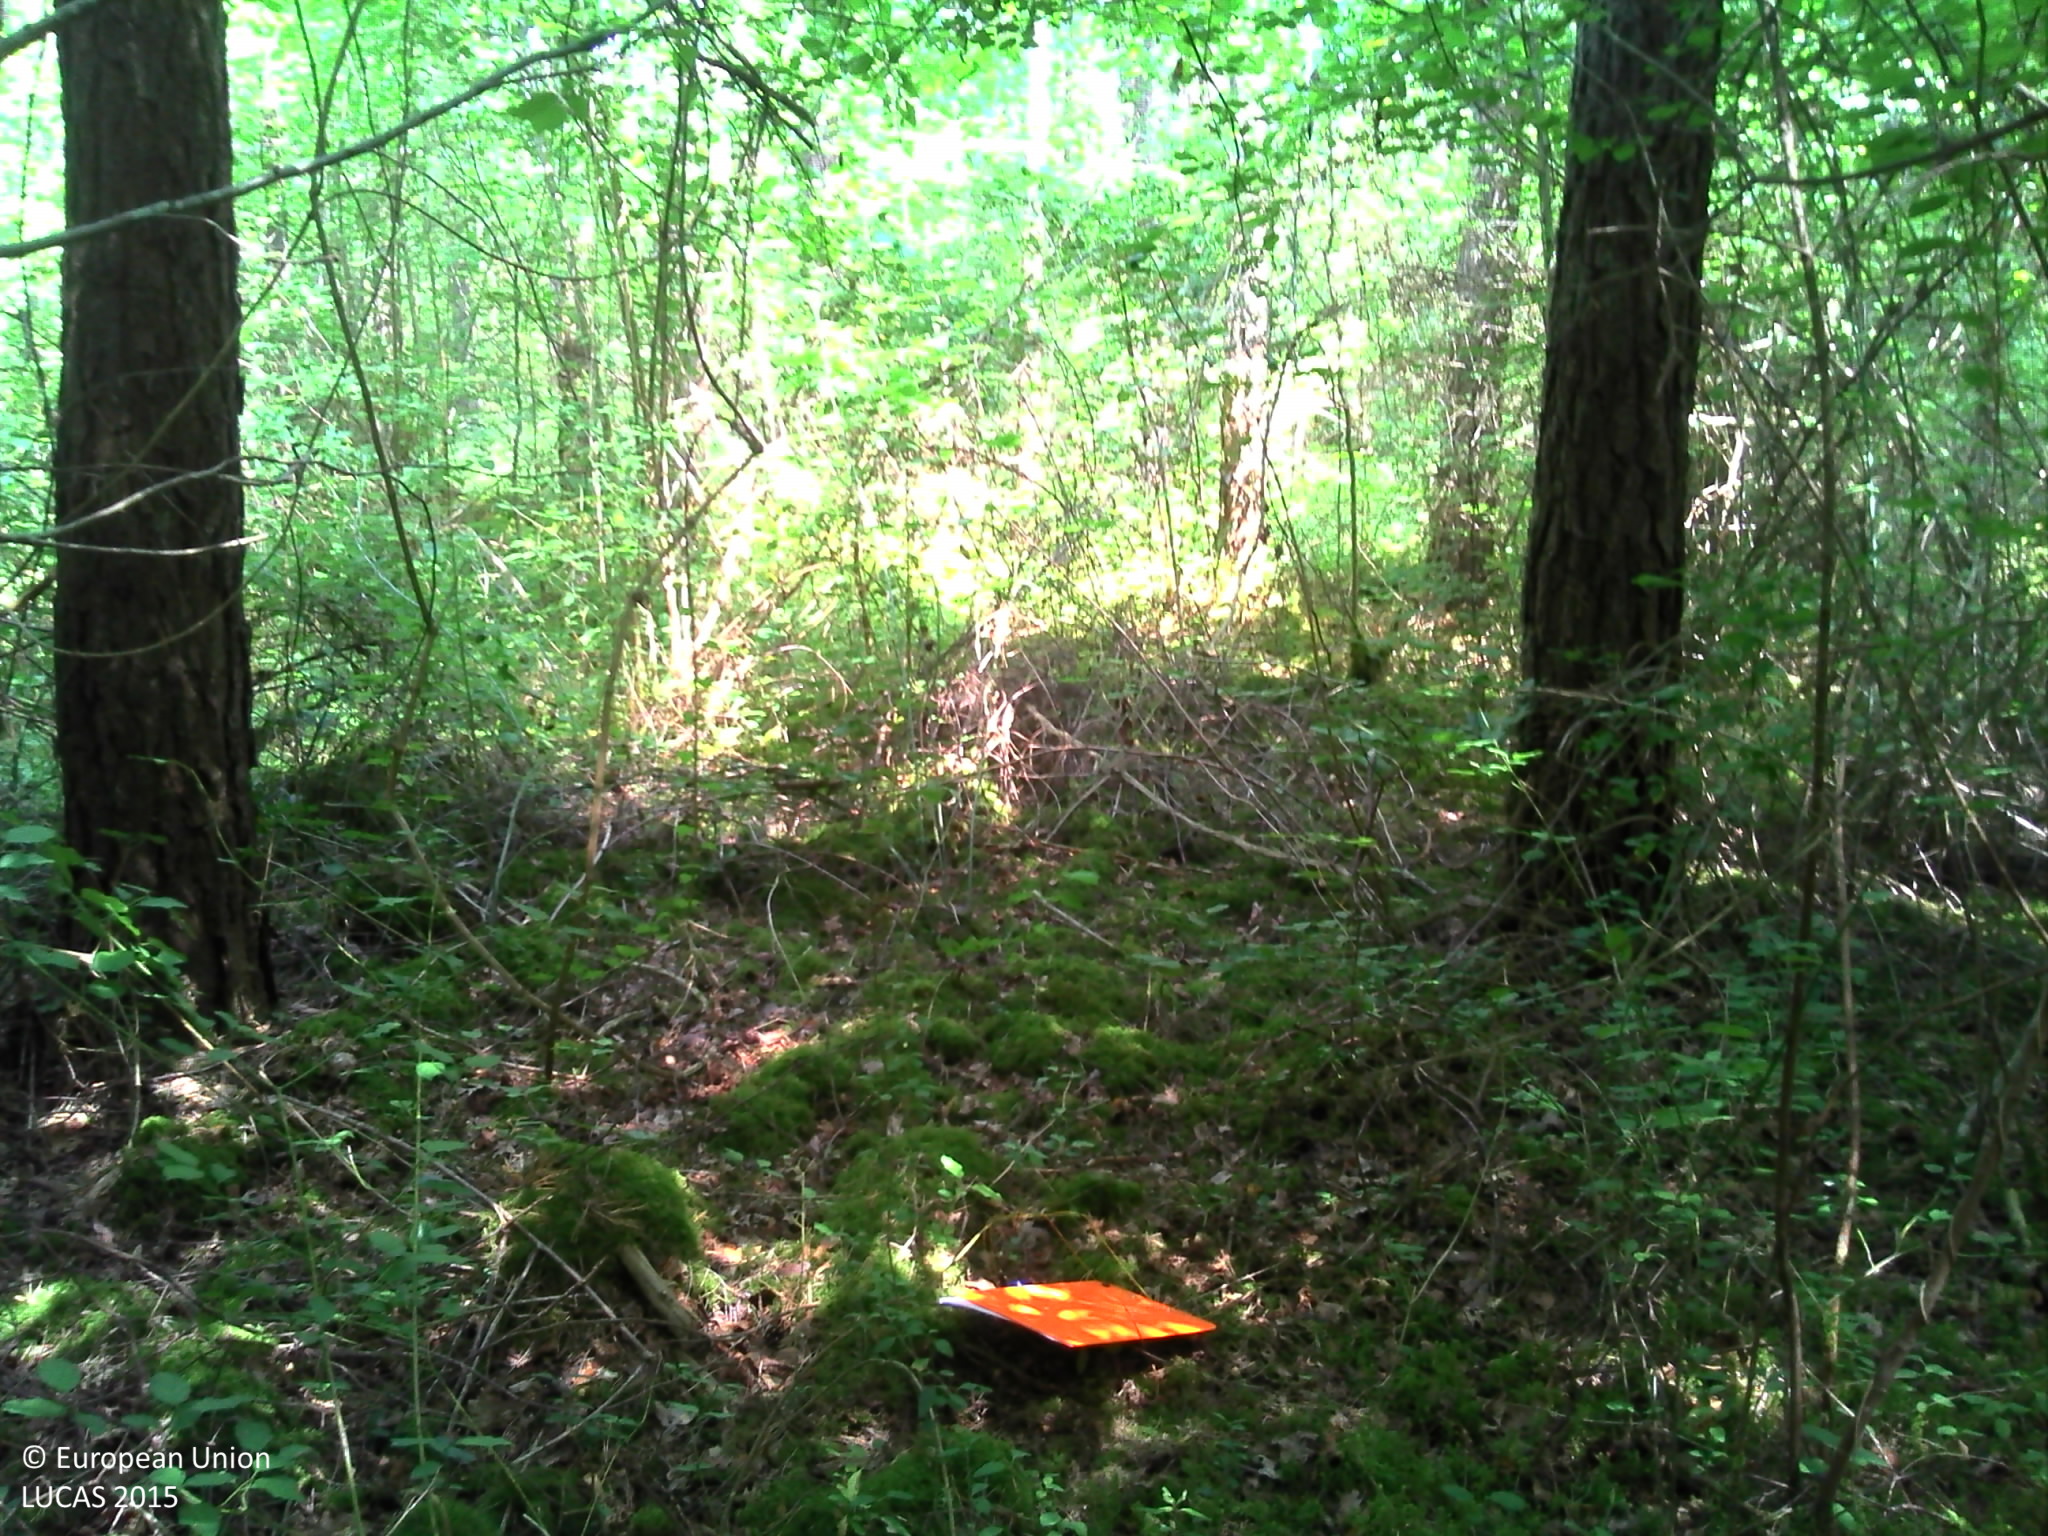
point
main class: Woodland
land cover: Pine dominated mixed woodland
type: hemiboreal forest and nemoral coniferous forest and mixed broadleaved-coniferous forest
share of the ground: > 75 %
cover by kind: coniferous forest trees 50 %, broadleaved forest trees 25 %, herbaceous plants 25 %
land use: Forestry
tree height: > 5 m
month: July
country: FR
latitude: 47.7551
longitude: 2.8294
